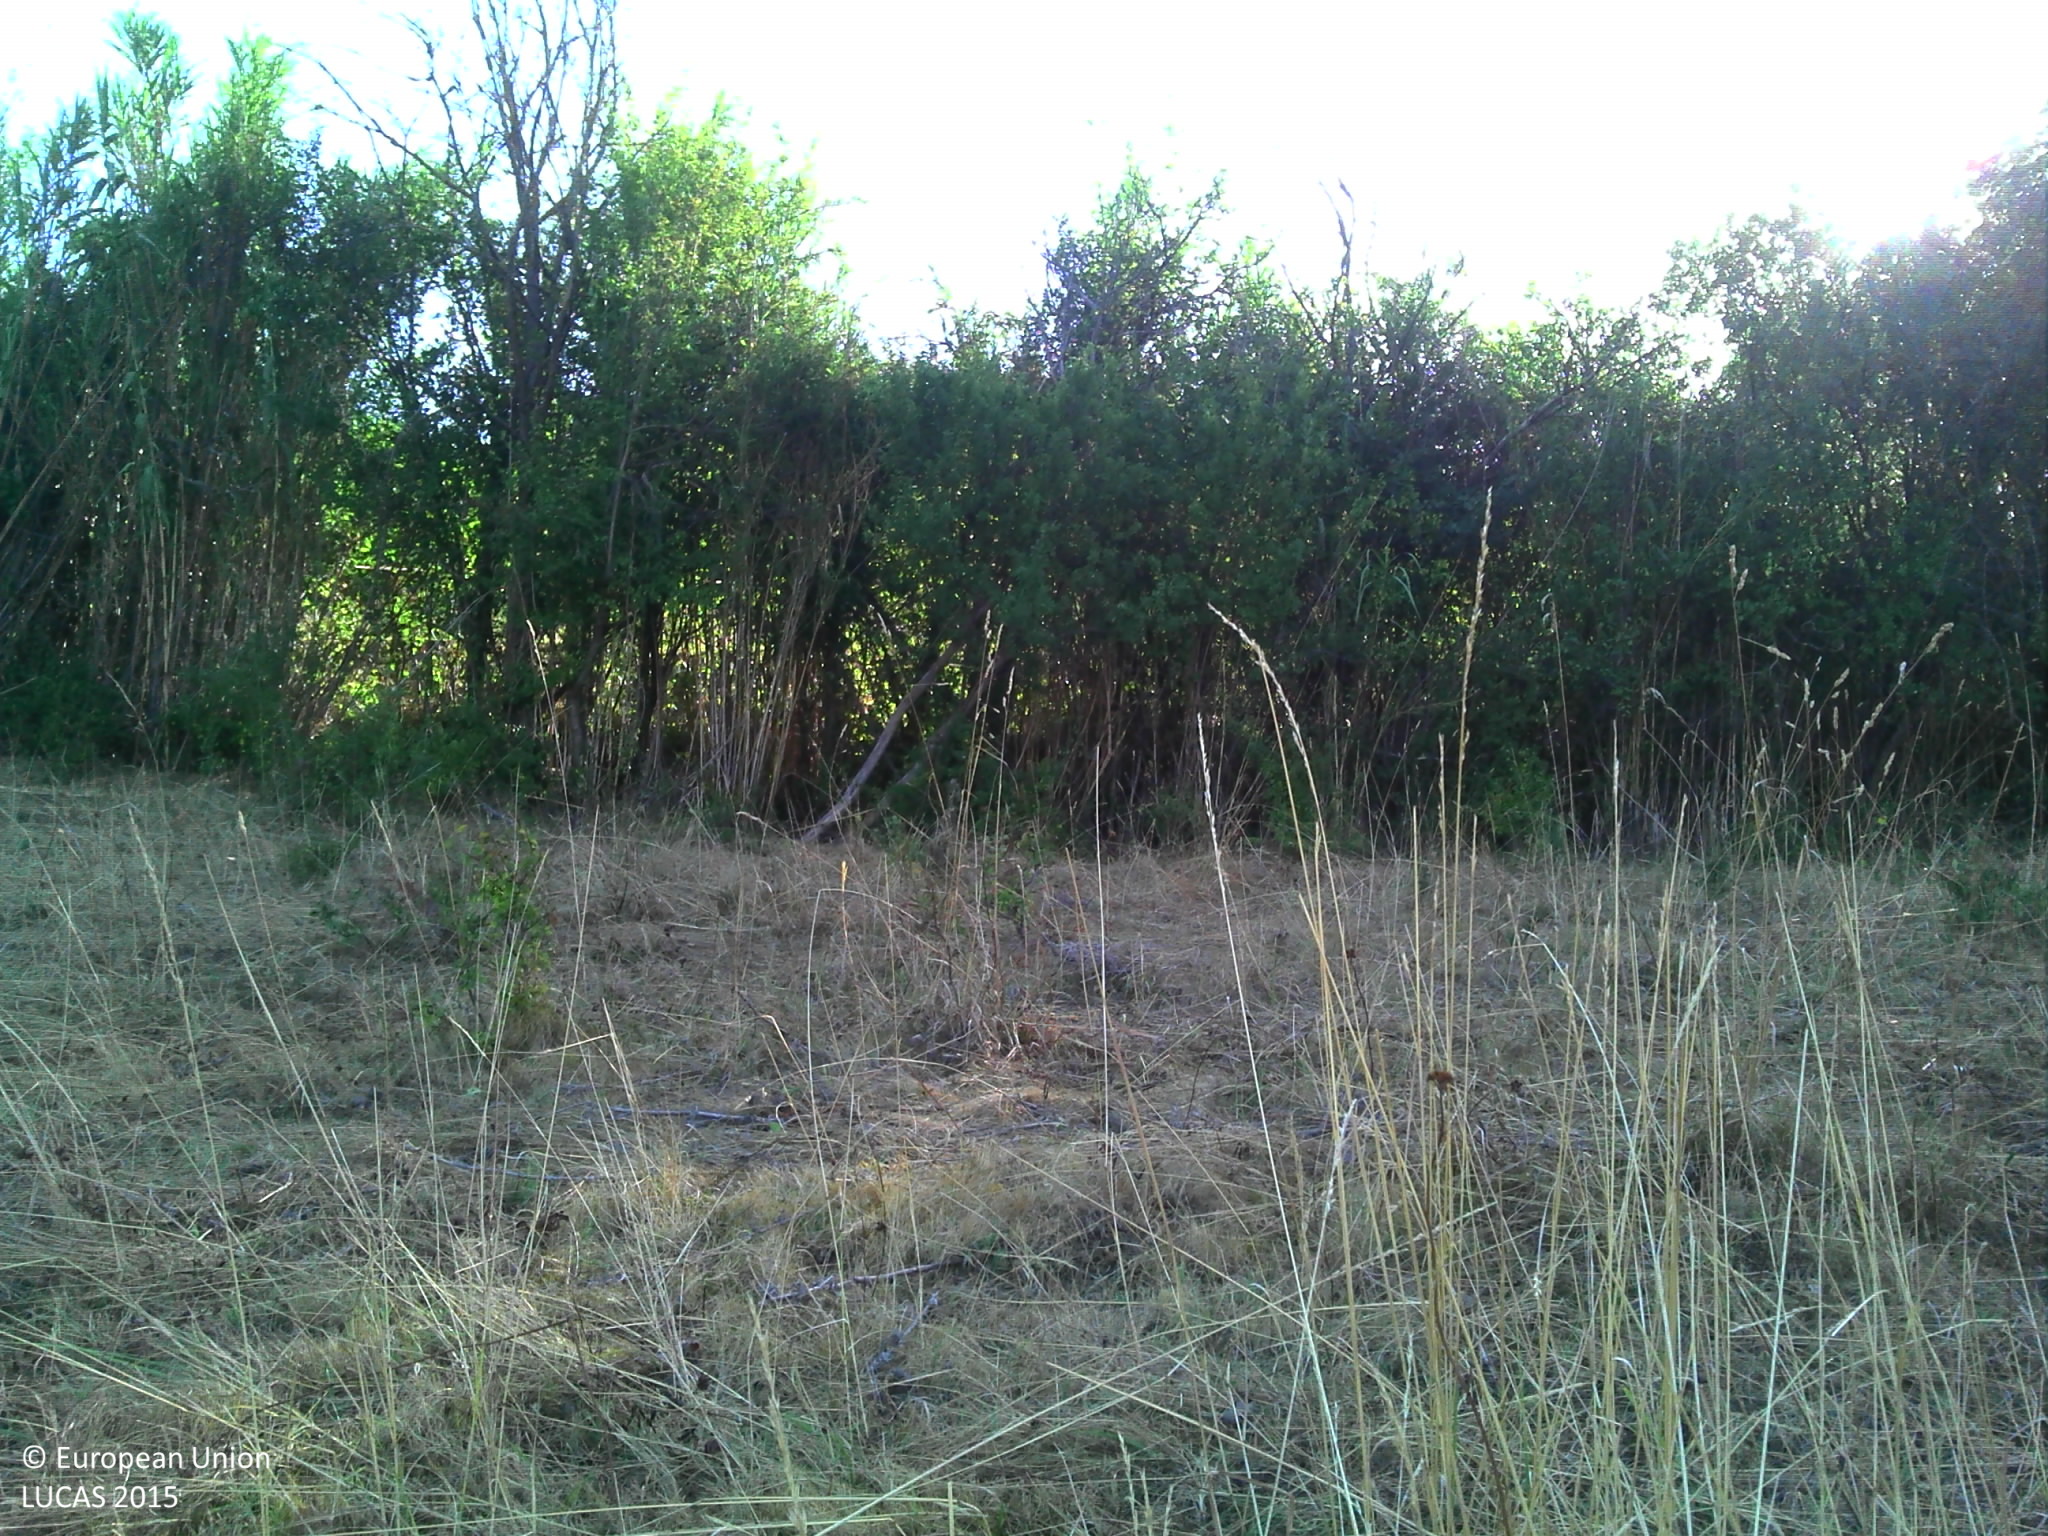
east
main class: Grassland
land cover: Grassland without tree/shrub cover
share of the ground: > 75 %
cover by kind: herbaceous plants 95 %, shrubs 5 %
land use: Agriculture (excluding fallow land and kitchen gardens)
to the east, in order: Grassland without tree/shrub cover; Electric lines; Grassland without tree/shrub cover; Broadleaved woodland; Fences; Grass margins; Paved roads, cycling and walking lanes; Grass margins; Ditches and canals; Fences; Abandoned hedges; Shrubland without tree cover; Broadleaved woodland; Fences; Broadleaved woodland; Tracks; Rape and turnip rape; Electric lines; Rape and turnip rape
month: July
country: FR
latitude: 44.3381
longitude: 0.5743
